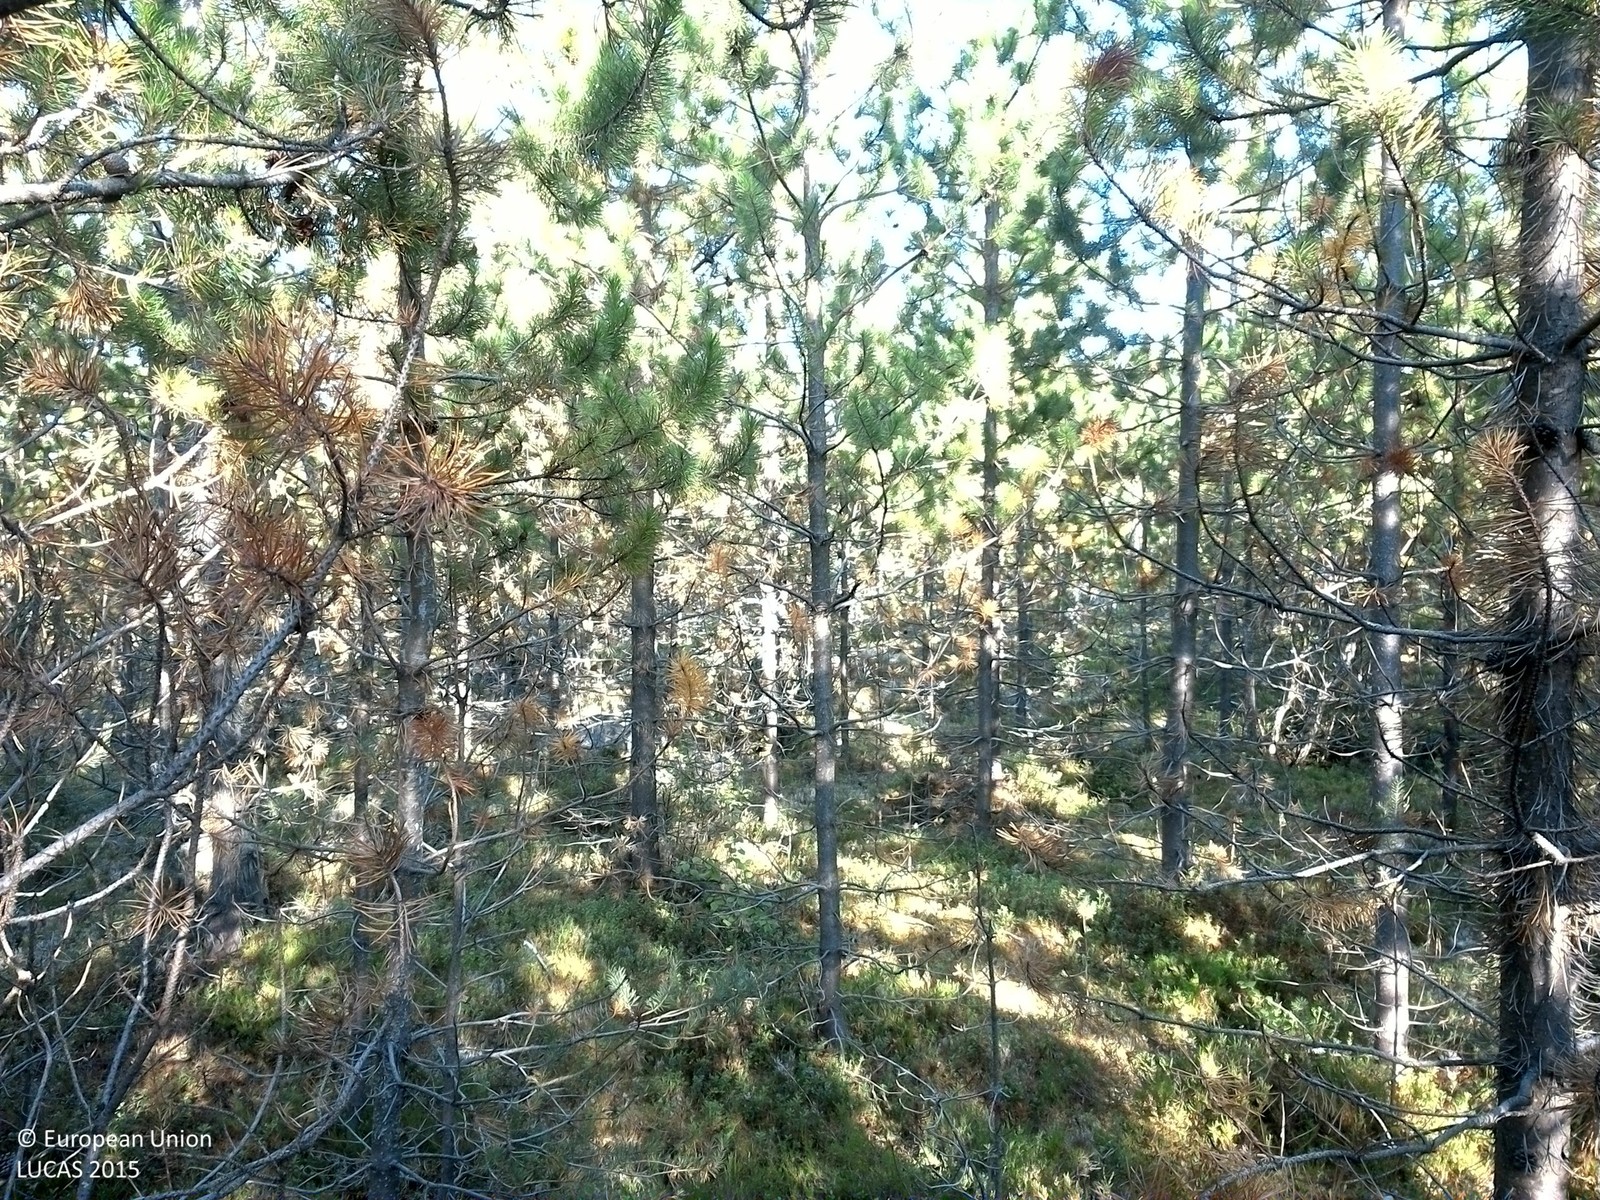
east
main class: Woodland
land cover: Pine dominated coniferous woodland
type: exotic forest
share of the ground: 50 - 75 %
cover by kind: coniferous forest trees 50 %, shrubs 25 %, lichens and mosses 15 %, broadleaved forest trees 5 %, consolidated bare surface 5 %
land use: Forestry
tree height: > 5 m
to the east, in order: Pine dominated coniferous woodland; Spruce dominated mixed woodland; Pine dominated coniferous woodland; Paved roads, cycling and walking lanes; Pine dominated coniferous woodland
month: August
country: SE
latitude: 63.9098
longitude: 16.7578
